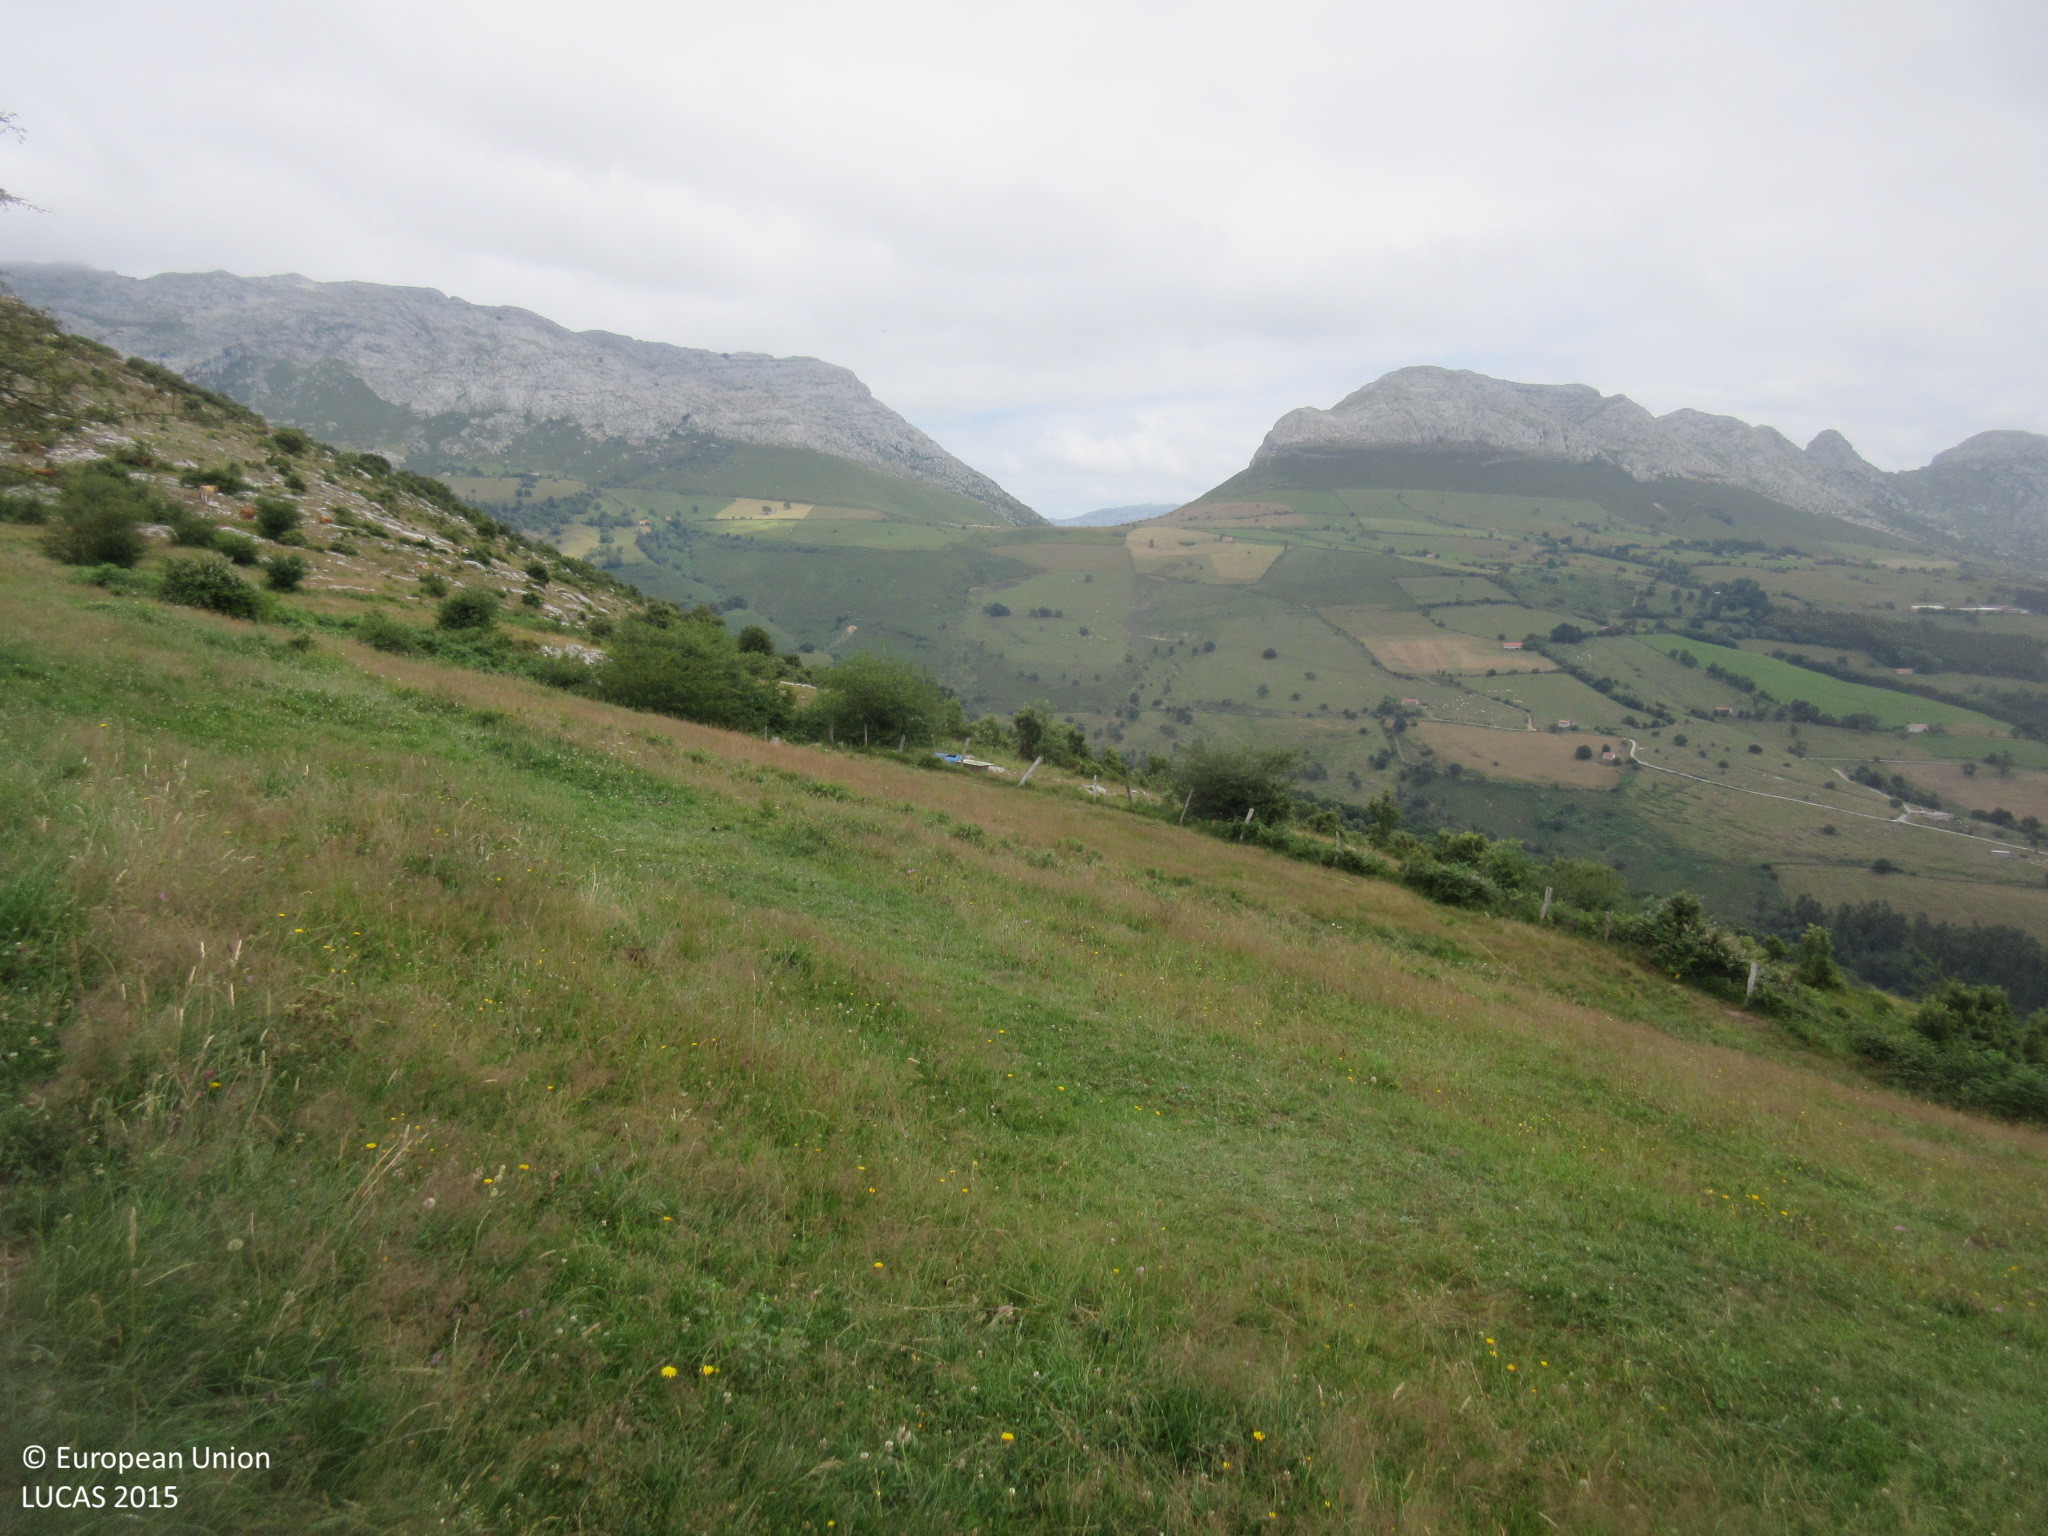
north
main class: Grassland
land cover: Grassland without tree/shrub cover
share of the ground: > 75 %
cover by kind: herbaceous plants 100 %
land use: Agriculture (excluding fallow land and kitchen gardens)
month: July
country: ES
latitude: 43.2054
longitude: -3.5192
